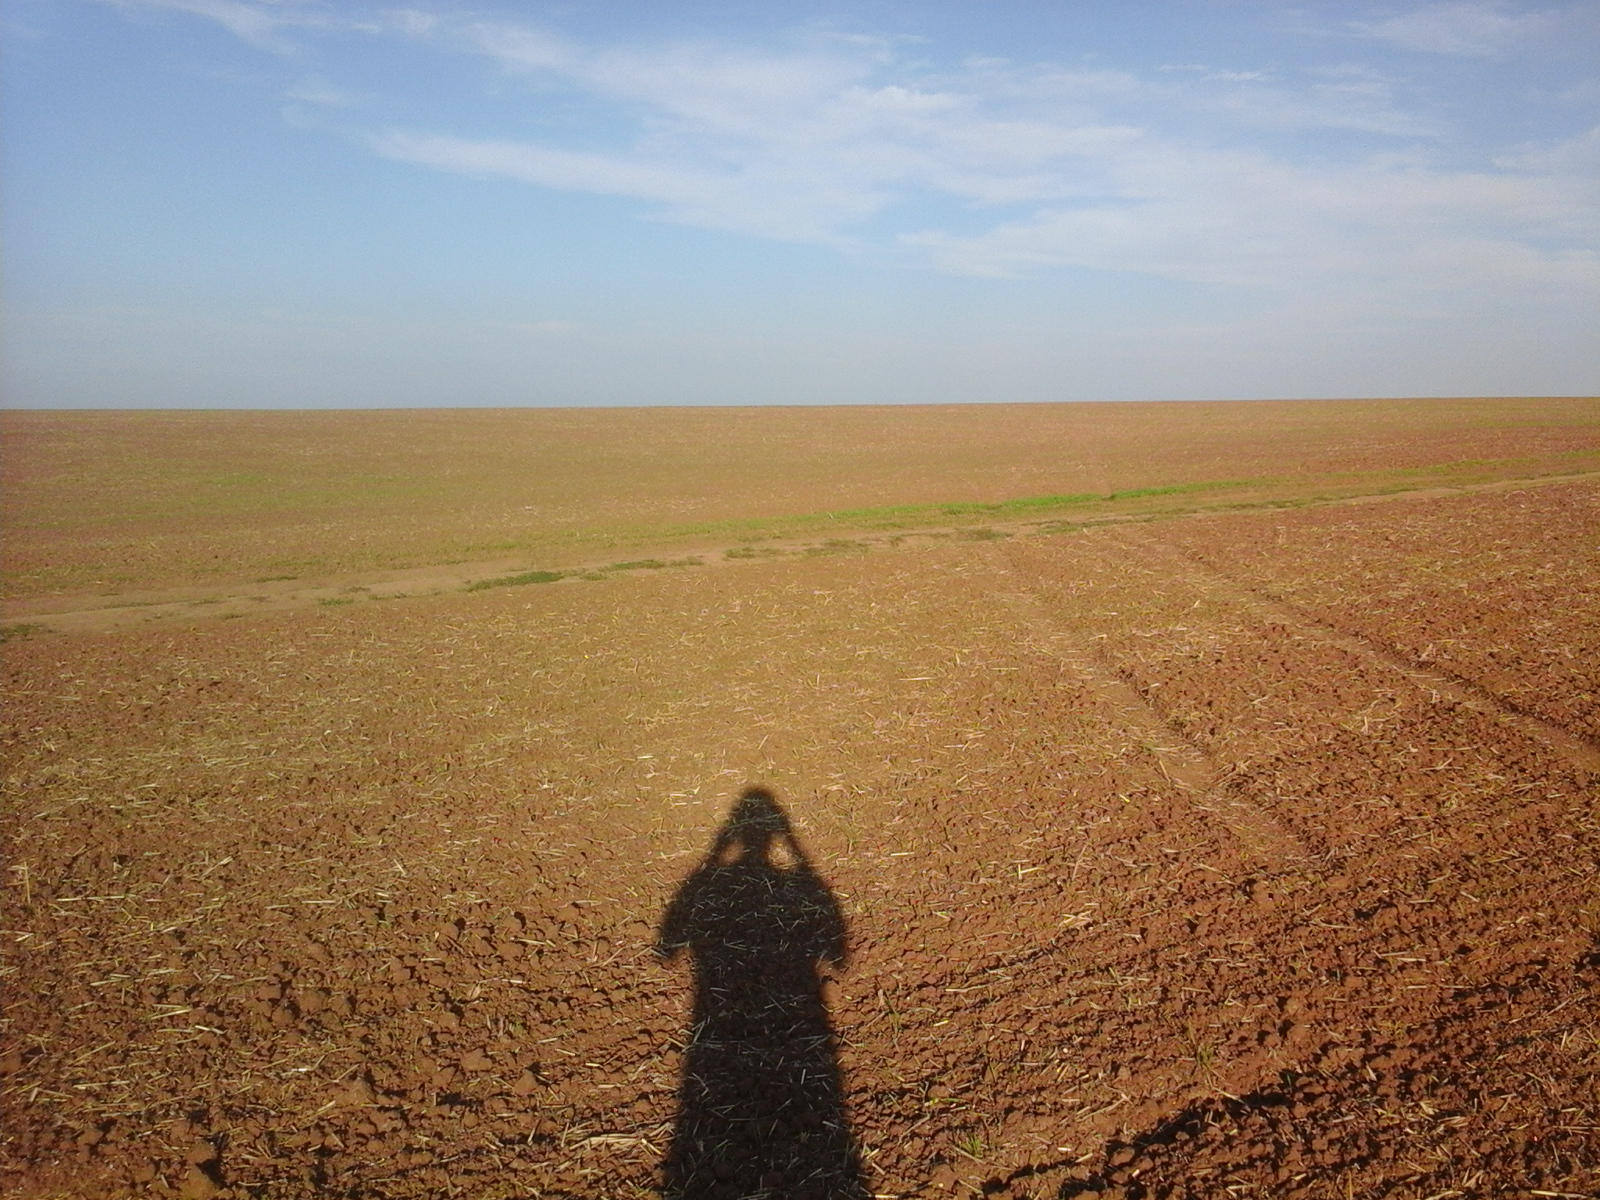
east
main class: Cropland
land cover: Common wheat
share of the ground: 10 - 25 %
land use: Agriculture (excluding fallow land and kitchen gardens)
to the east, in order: Common wheat; Tracks; Common wheat
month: August
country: RO
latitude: 46.0015
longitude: 21.3318
